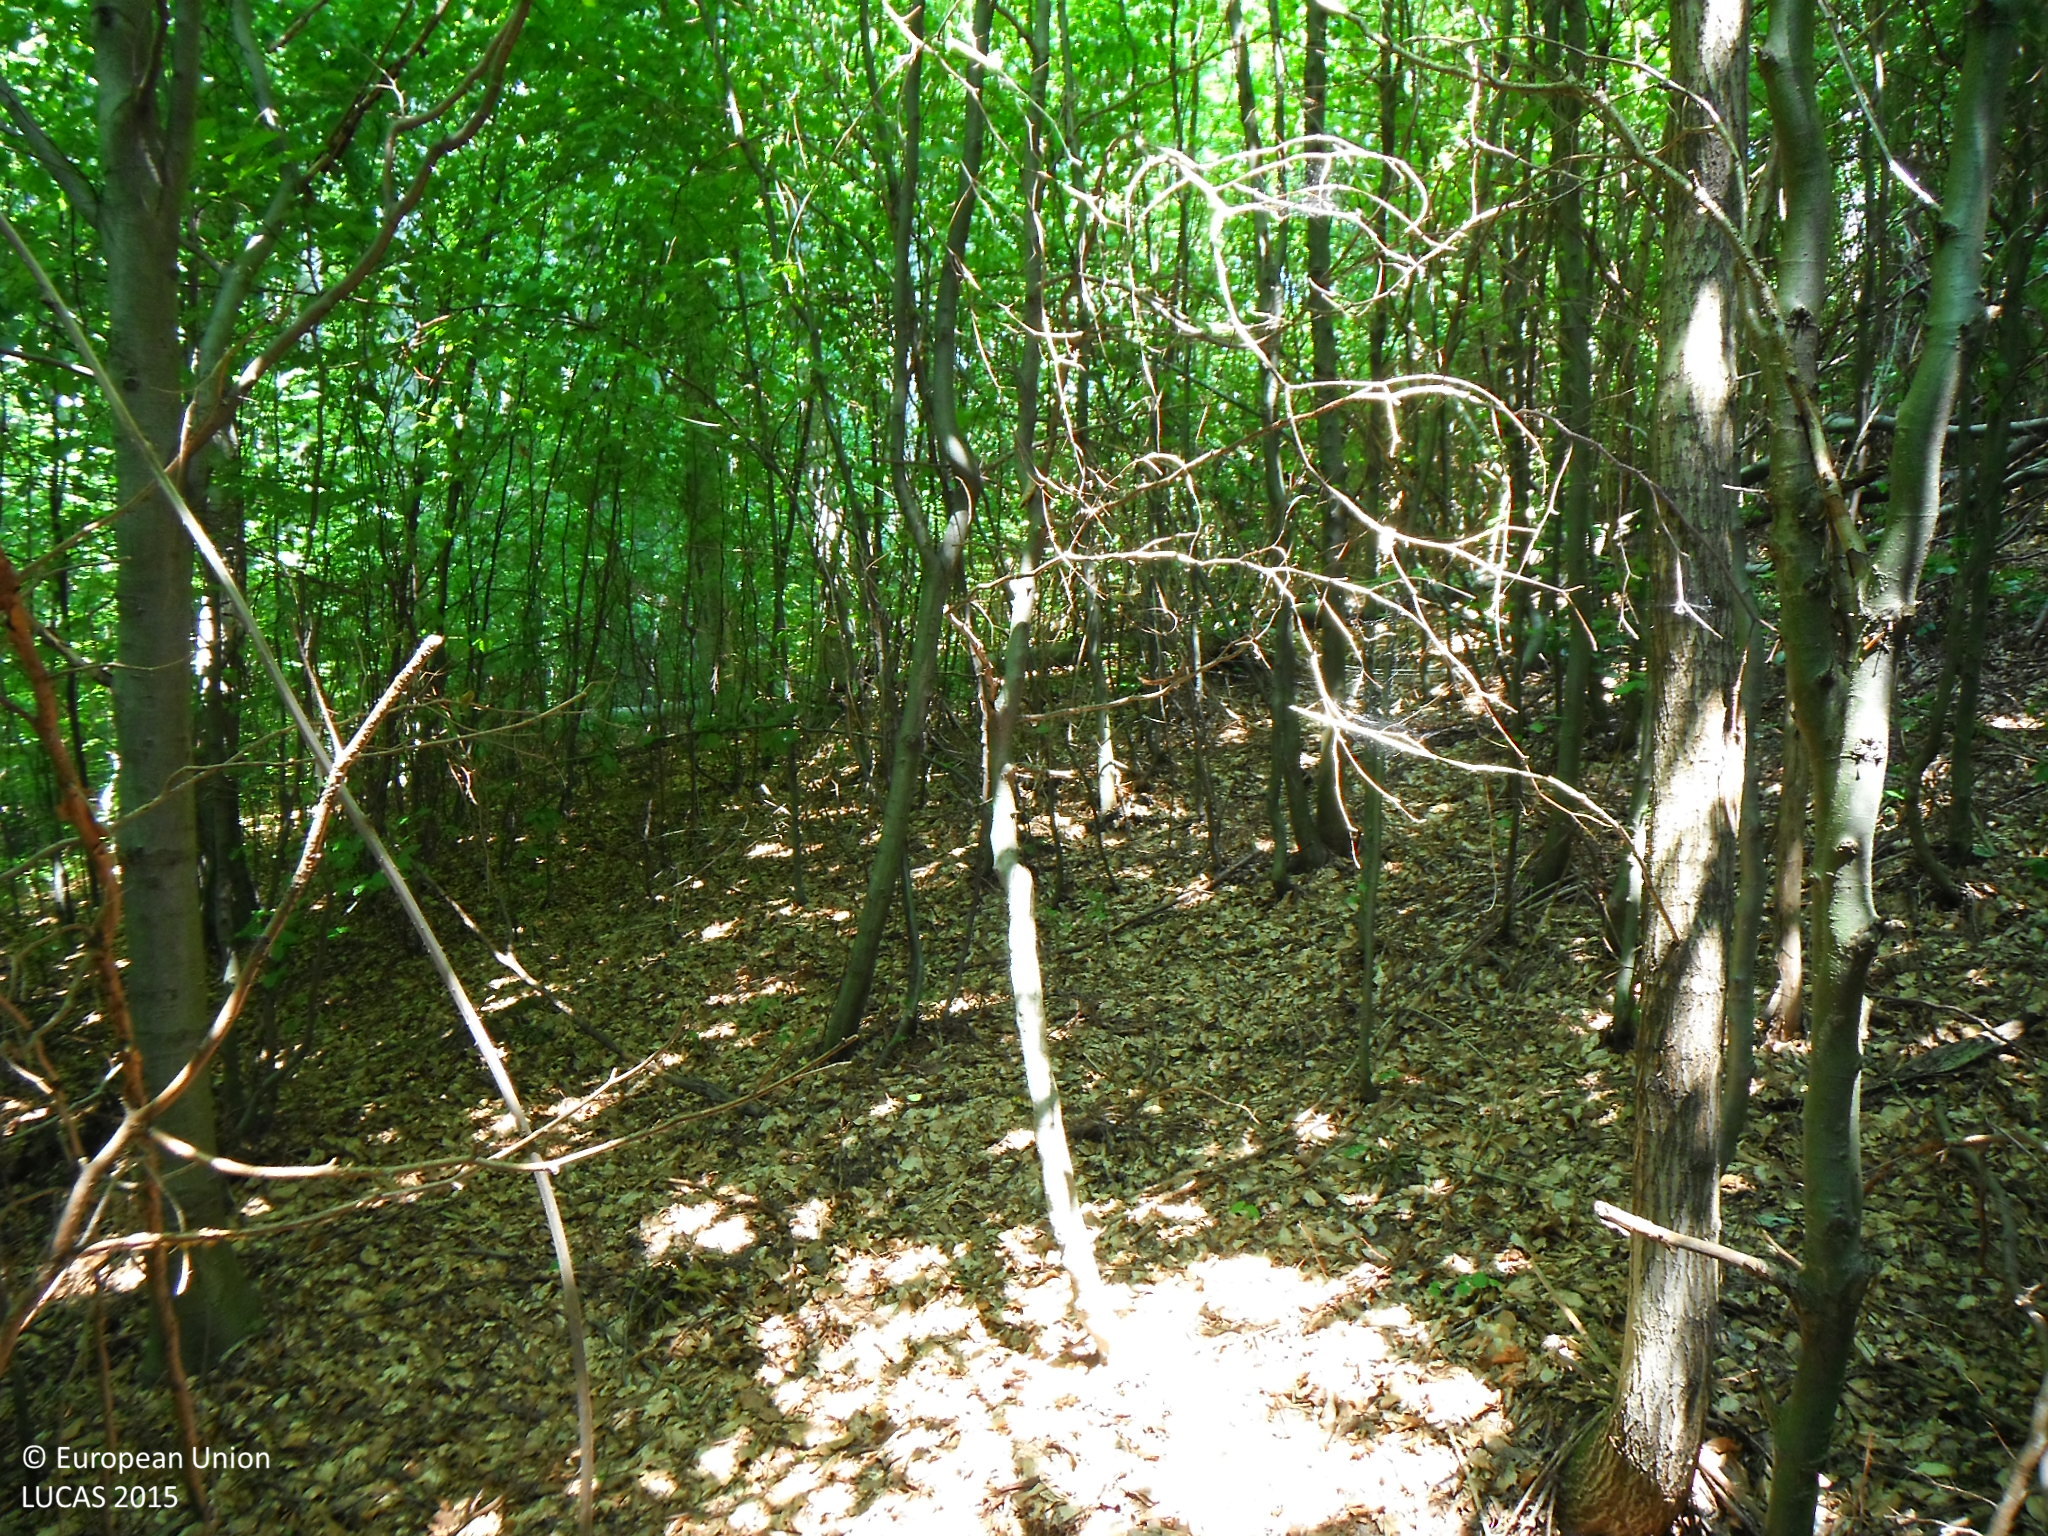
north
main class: Woodland
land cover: Broadleaved woodland
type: beech forest
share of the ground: > 75 %
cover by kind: broadleaved forest trees 100 %
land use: Forestry
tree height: > 5 m
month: July
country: SK
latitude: 49.3526
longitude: 21.4332
